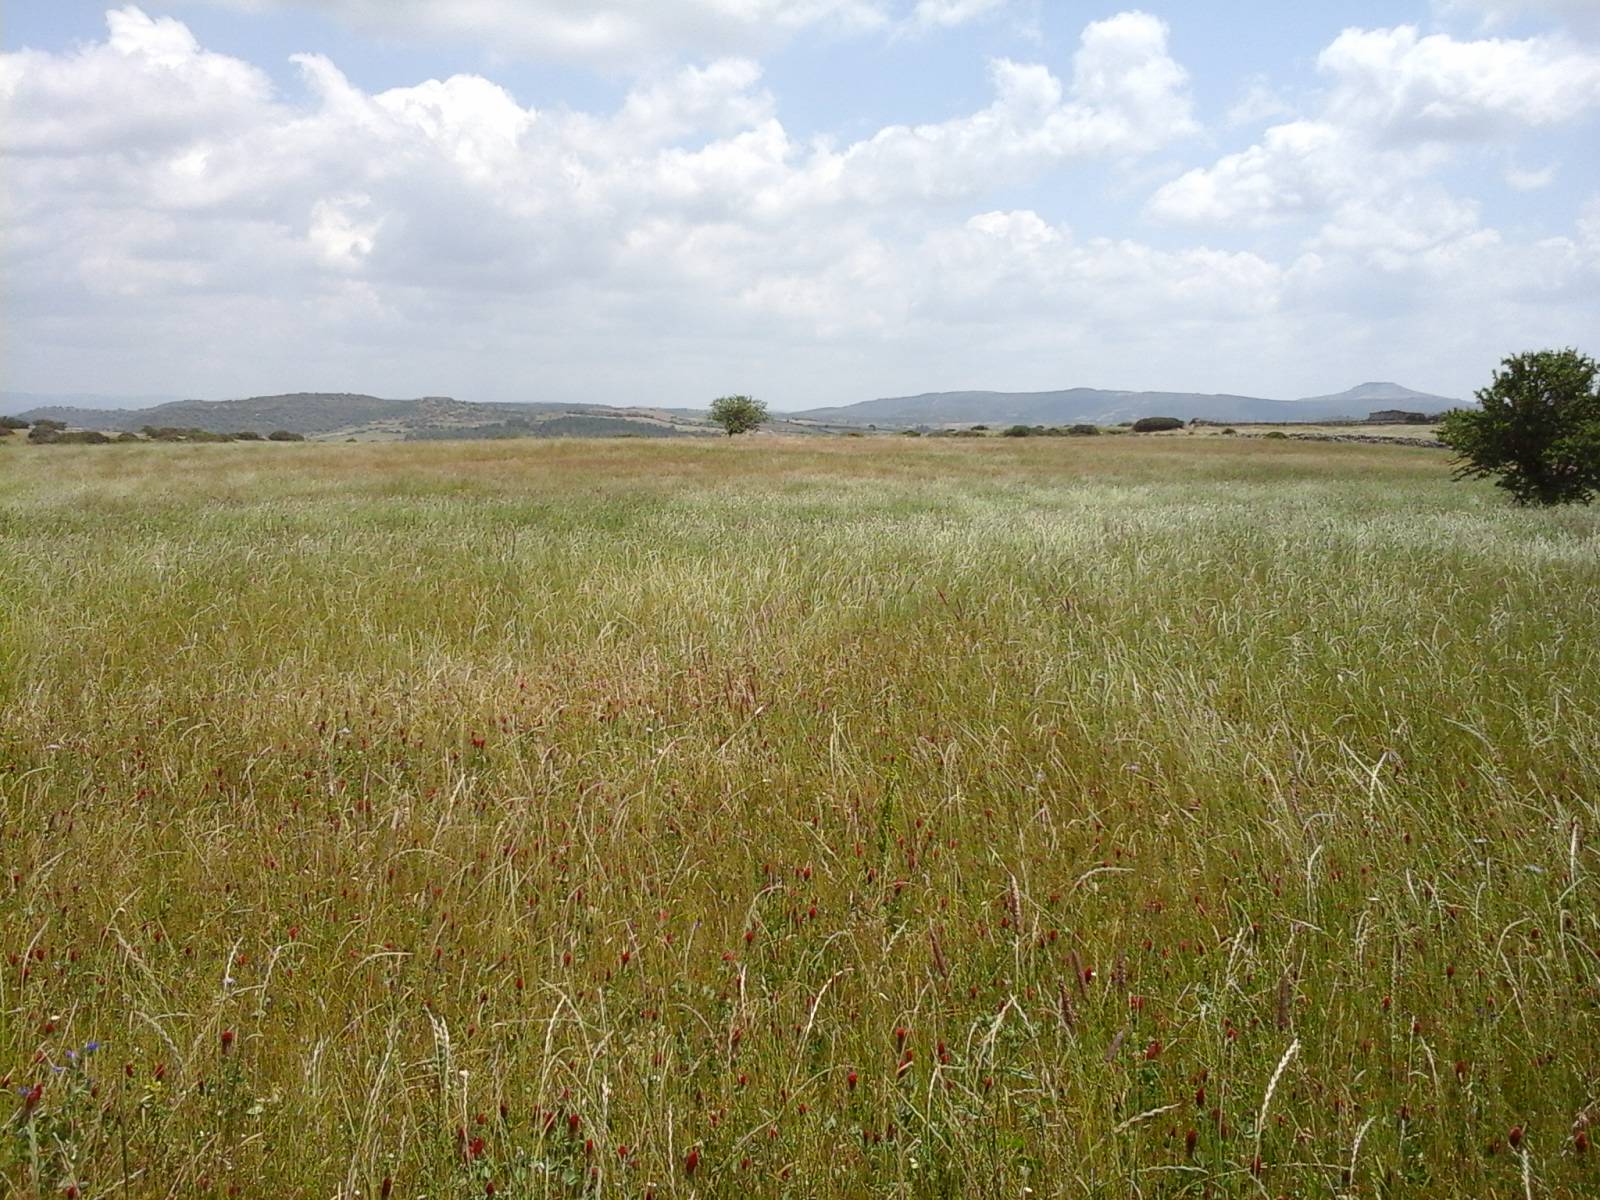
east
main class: Cropland
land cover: Other leguminous and mixtures for fodder
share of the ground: > 75 %
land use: Agriculture (excluding fallow land and kitchen gardens)
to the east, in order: Other leguminous and mixtures for fodder; Fences; Grassland without tree/shrub cover; Abandoned hedges; Dry stone walls; Fences
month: May
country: IT
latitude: 39.8265
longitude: 8.8963
